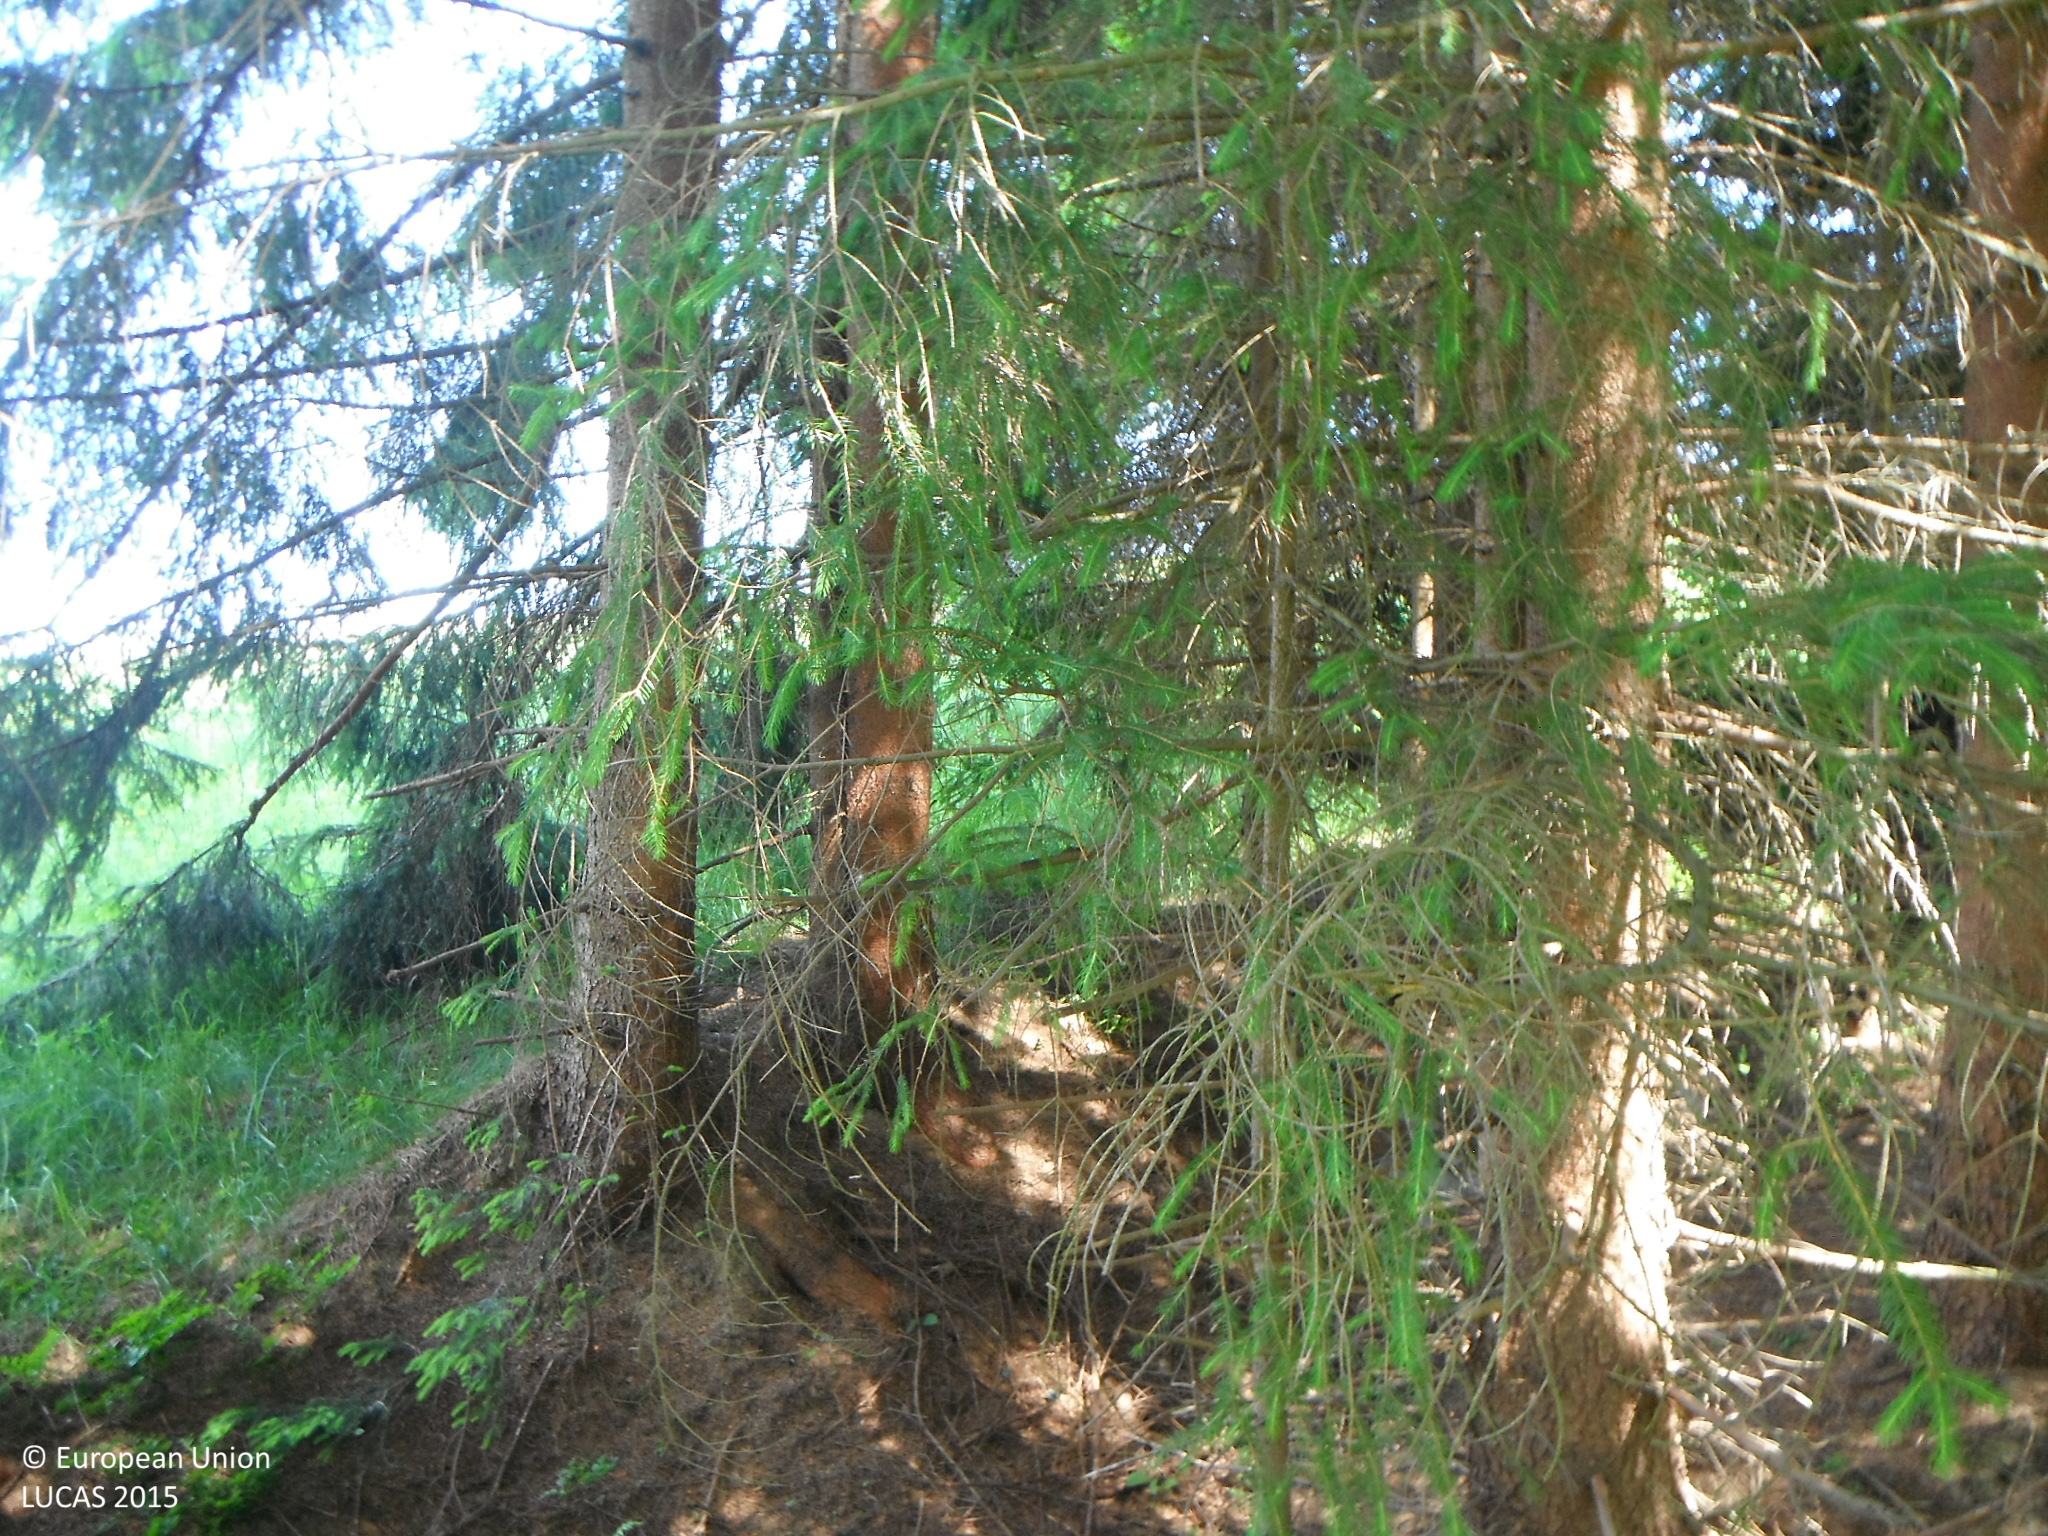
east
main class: Woodland
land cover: Spruce dominated coniferous woodland
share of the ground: > 75 %
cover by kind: coniferous forest trees 80 %, herbaceous plants 10 %, lichens and mosses 5 %, unconsolidated bare surface 5 %
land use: Forestry
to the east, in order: Spruce dominated coniferous woodland; Spontaneously vegetated surfaces; Clovers; Electric lines; Clovers
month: July
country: SK
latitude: 49.3808
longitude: 19.1559
